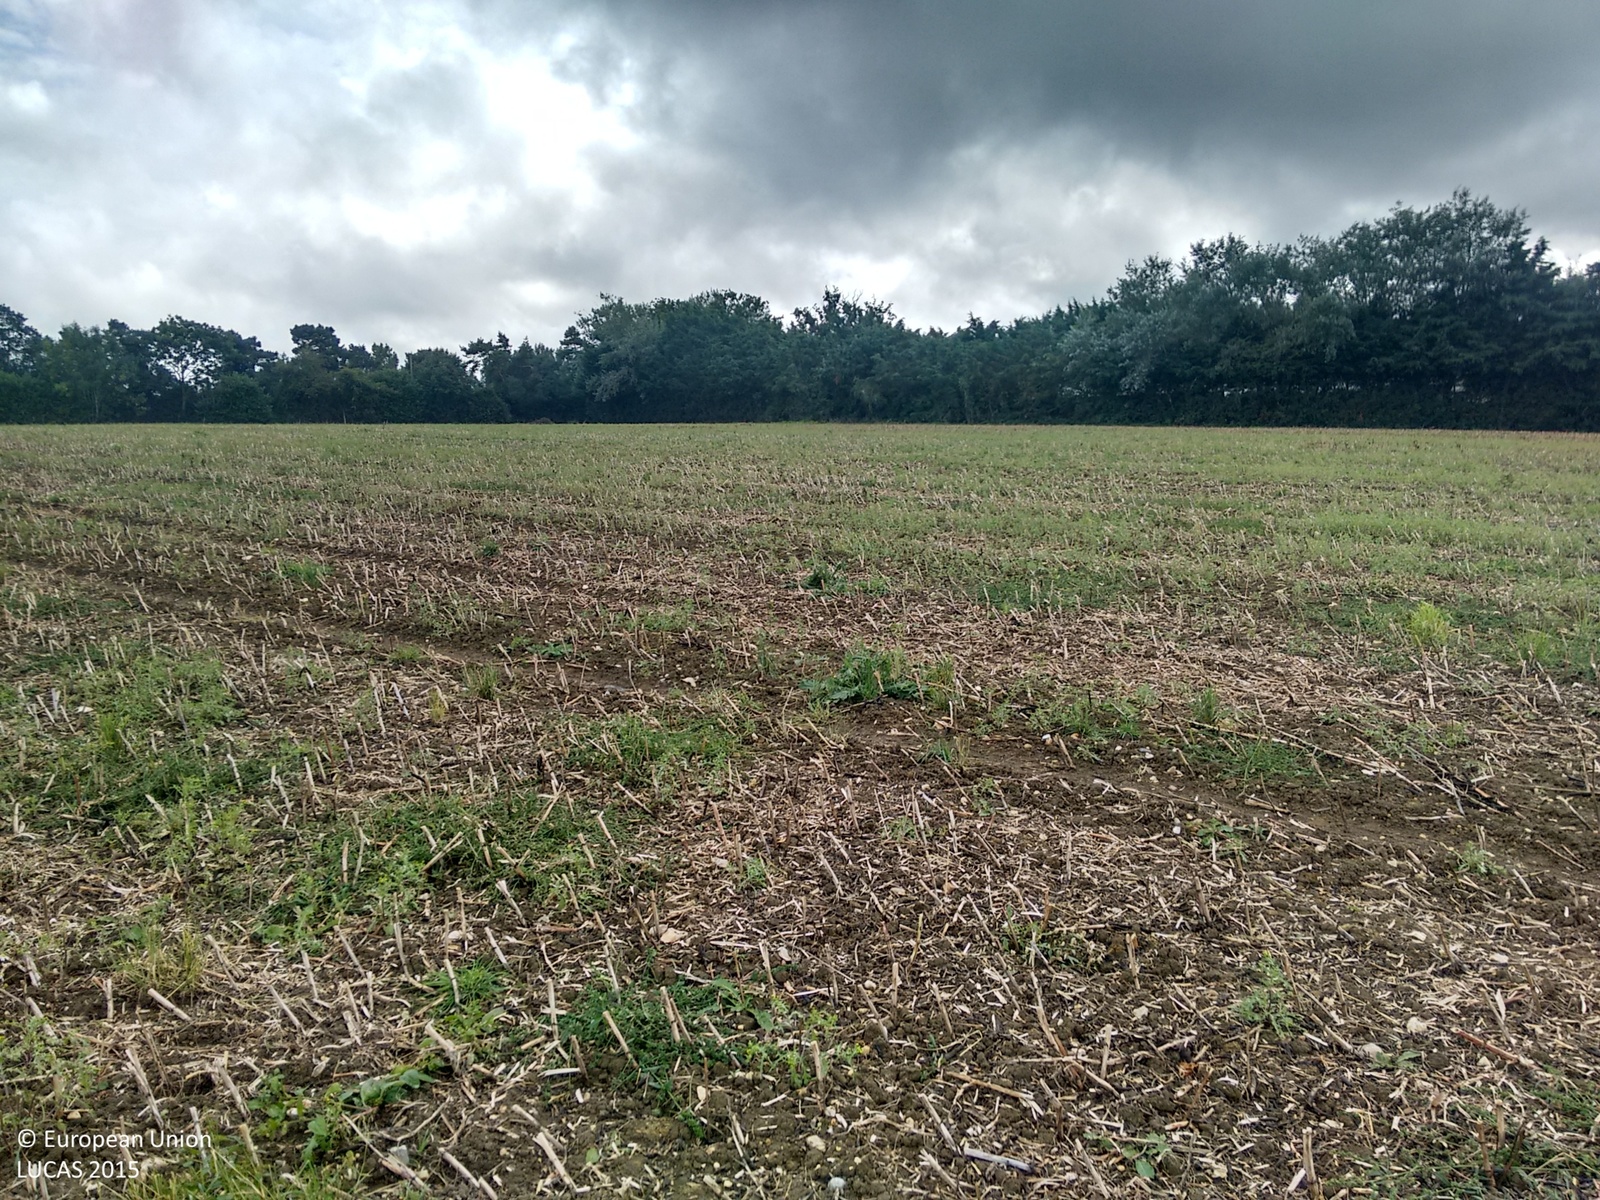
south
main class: Cropland
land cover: Dry pulses
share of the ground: 25 - 50 %
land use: Agriculture (excluding fallow land and kitchen gardens)
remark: Harvested field
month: September
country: GB
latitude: 52.3264
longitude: 1.5147
